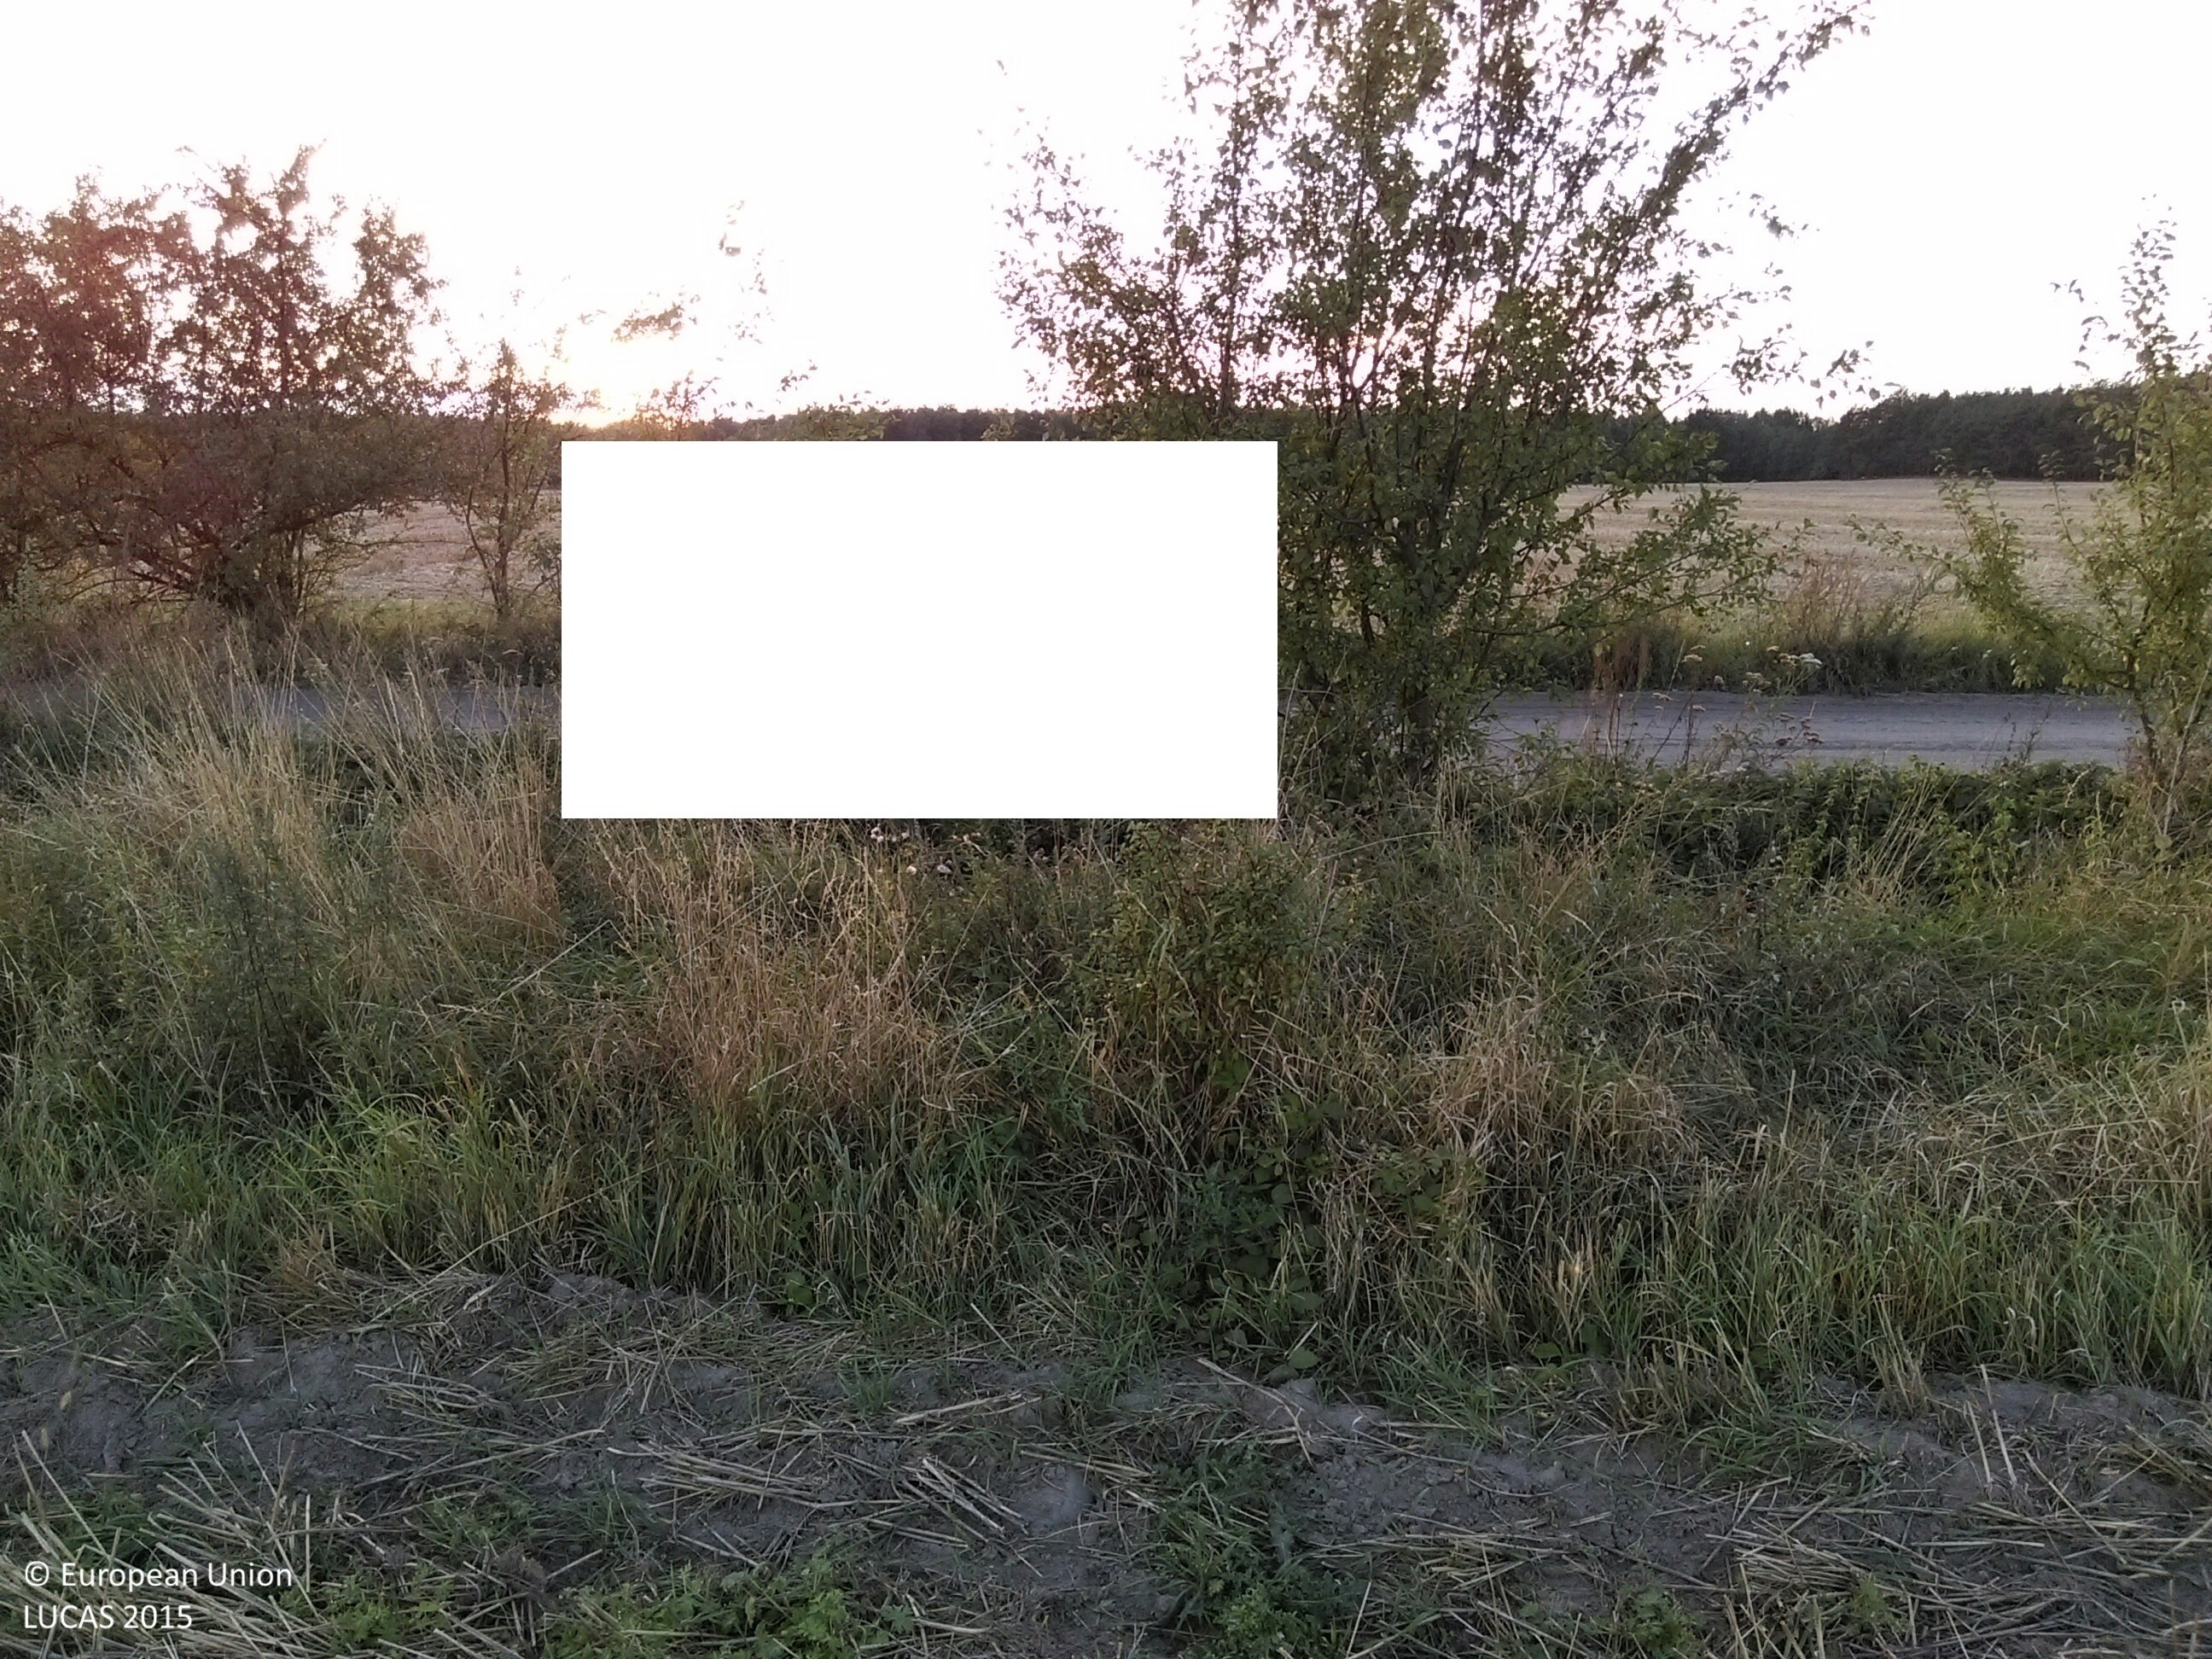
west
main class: Cropland
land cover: Rye
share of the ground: 10 - 25 %
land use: Agriculture (excluding fallow land and kitchen gardens)
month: September
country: PL
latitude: 52.1261
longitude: 16.1851
